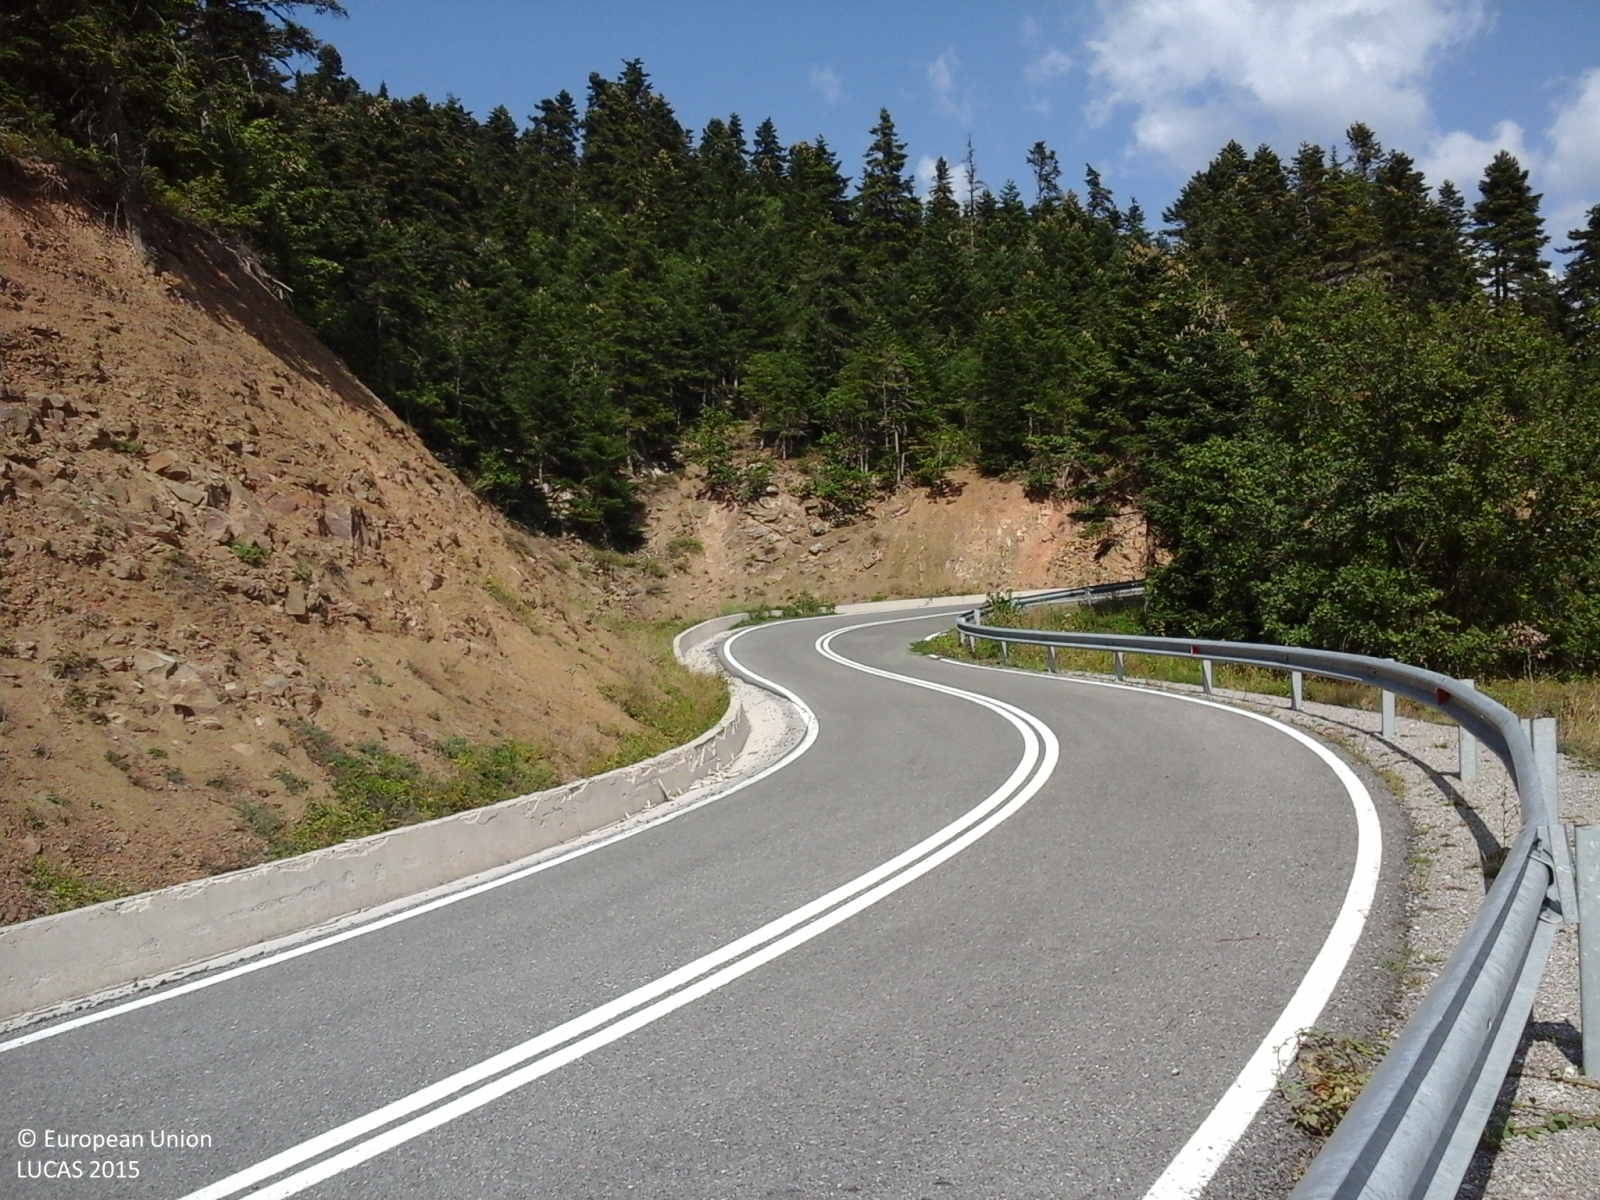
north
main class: Woodland
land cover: Spruce dominated mixed woodland
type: coniferous forest of the mediterranean region
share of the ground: > 75 %
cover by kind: coniferous forest trees 75 %, broadleaved forest trees 25 %
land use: Forestry
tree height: > 5 m
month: September
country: GR
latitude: 38.7192
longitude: 22.1793
